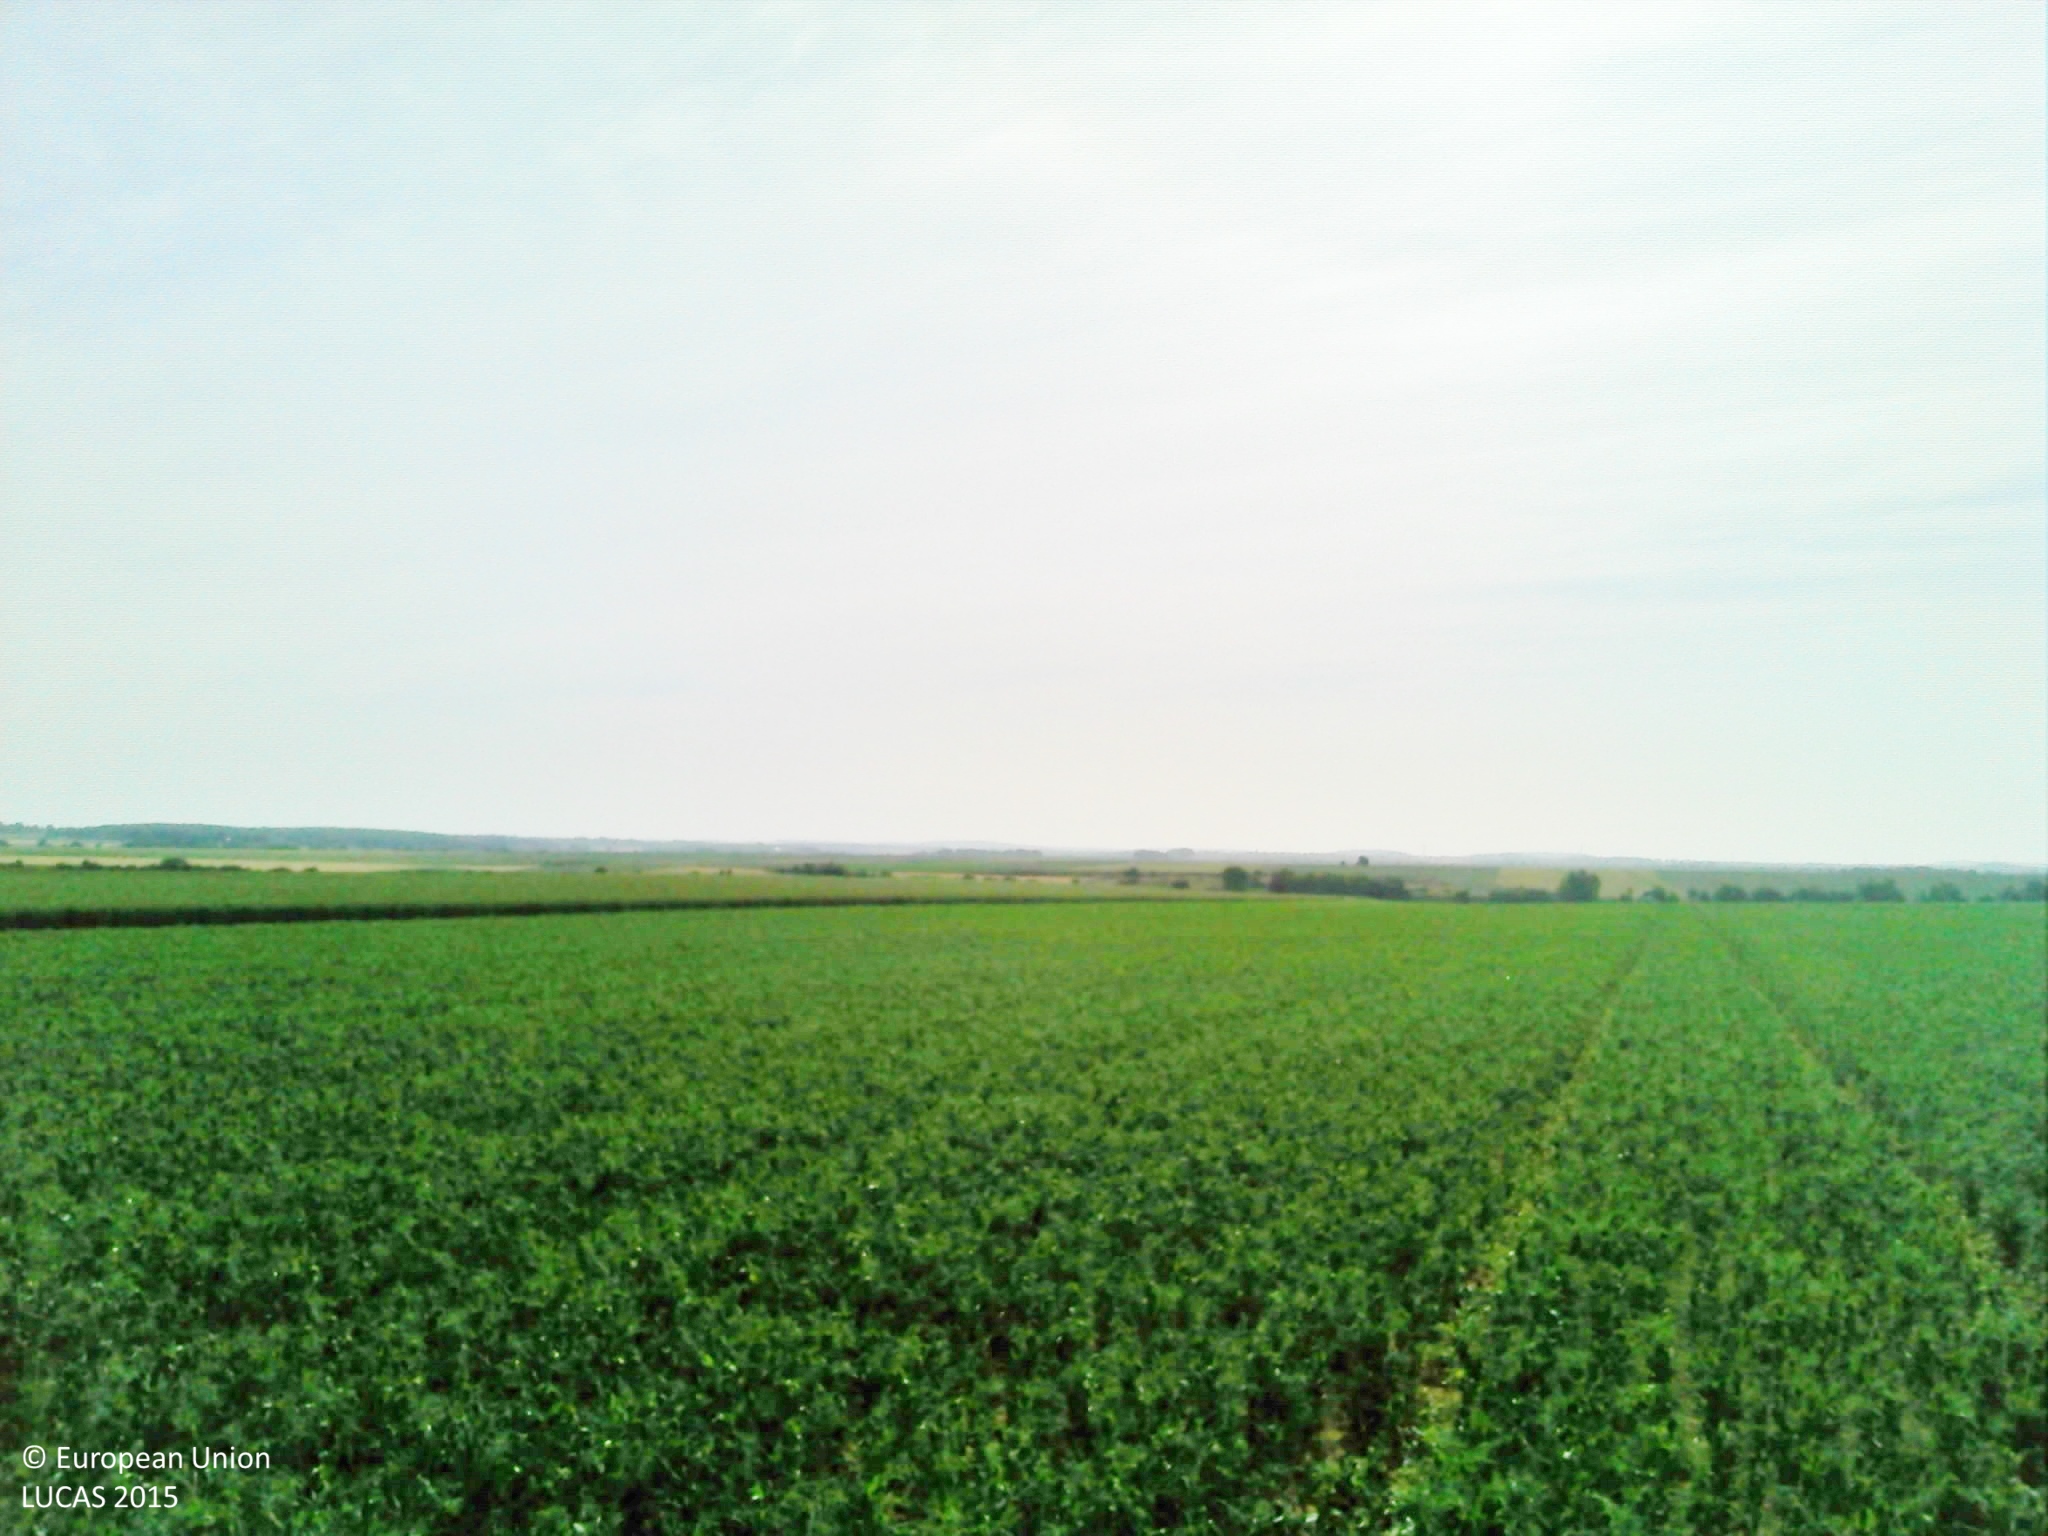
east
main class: Cropland
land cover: Dry pulses
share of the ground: > 75 %
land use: Agriculture (excluding fallow land and kitchen gardens)
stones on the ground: < 10 %
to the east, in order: Dry pulses
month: June
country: FR
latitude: 49.5102
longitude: 2.5997
